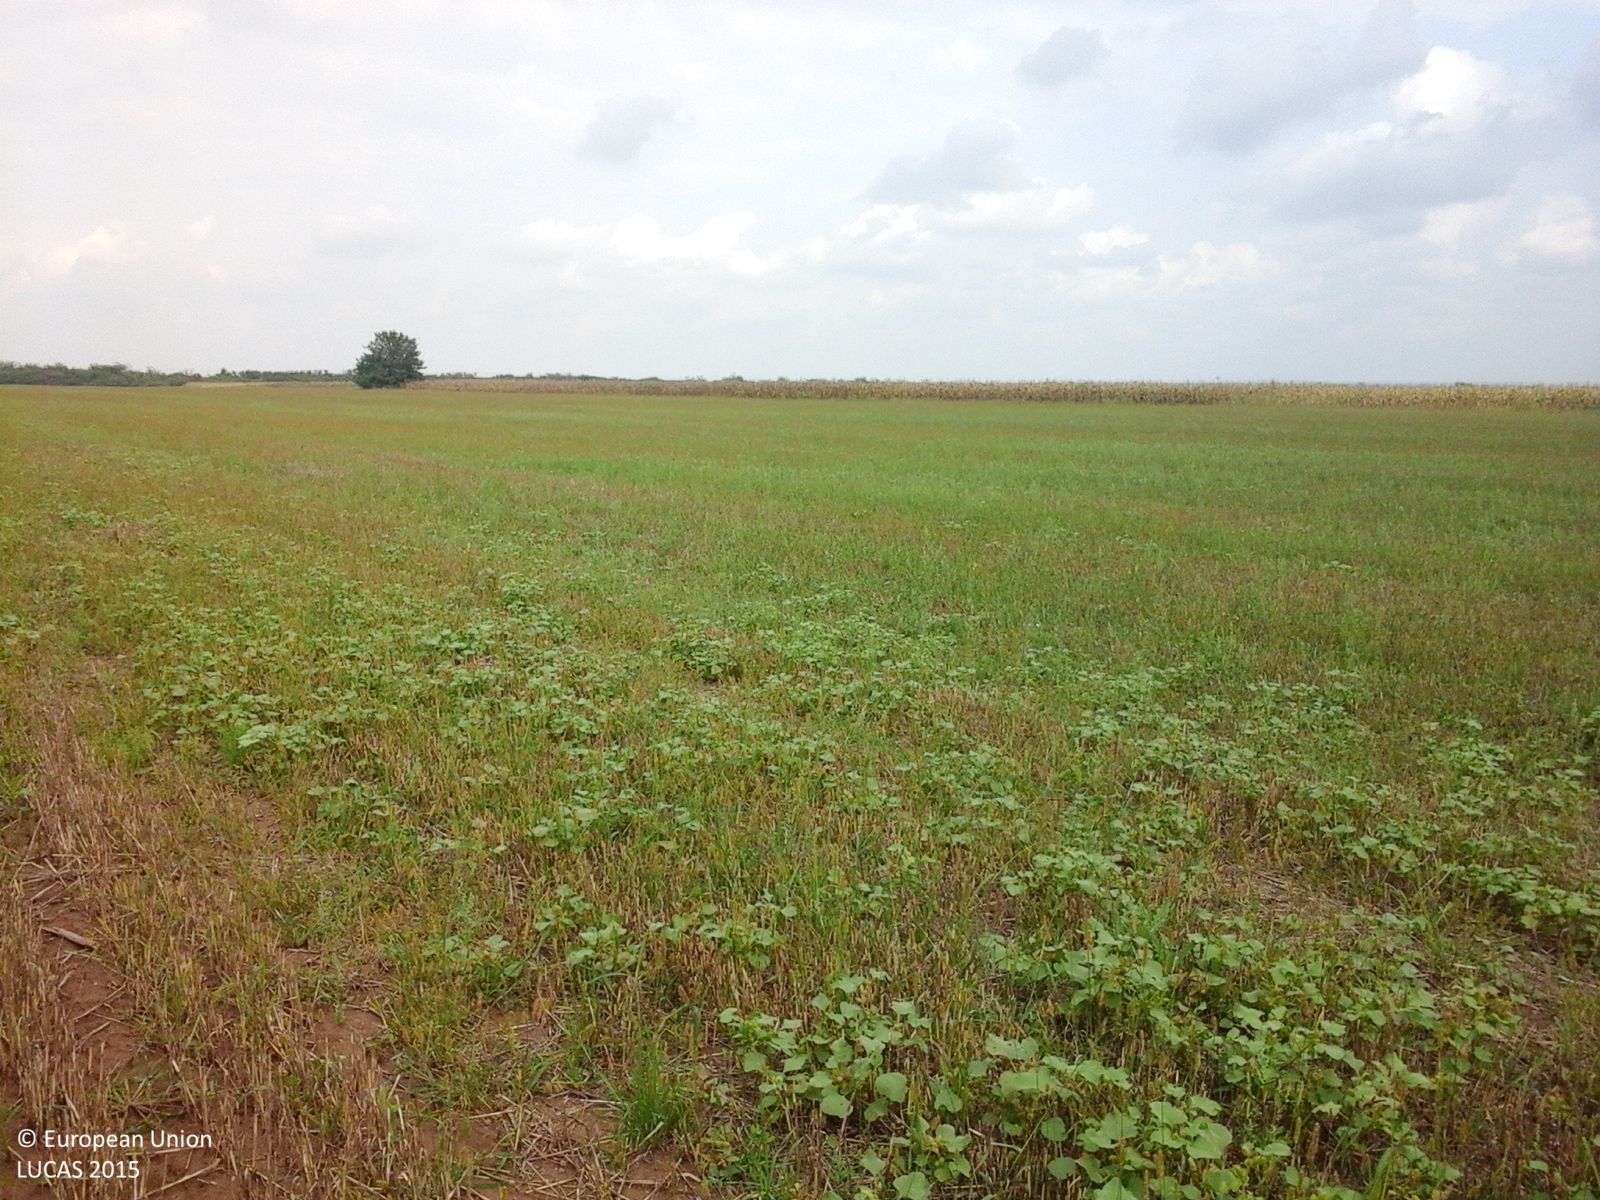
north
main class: Cropland
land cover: Maize
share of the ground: > 75 %
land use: Agriculture (excluding fallow land and kitchen gardens)
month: September
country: RO
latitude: 46.7317
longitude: 21.8072
